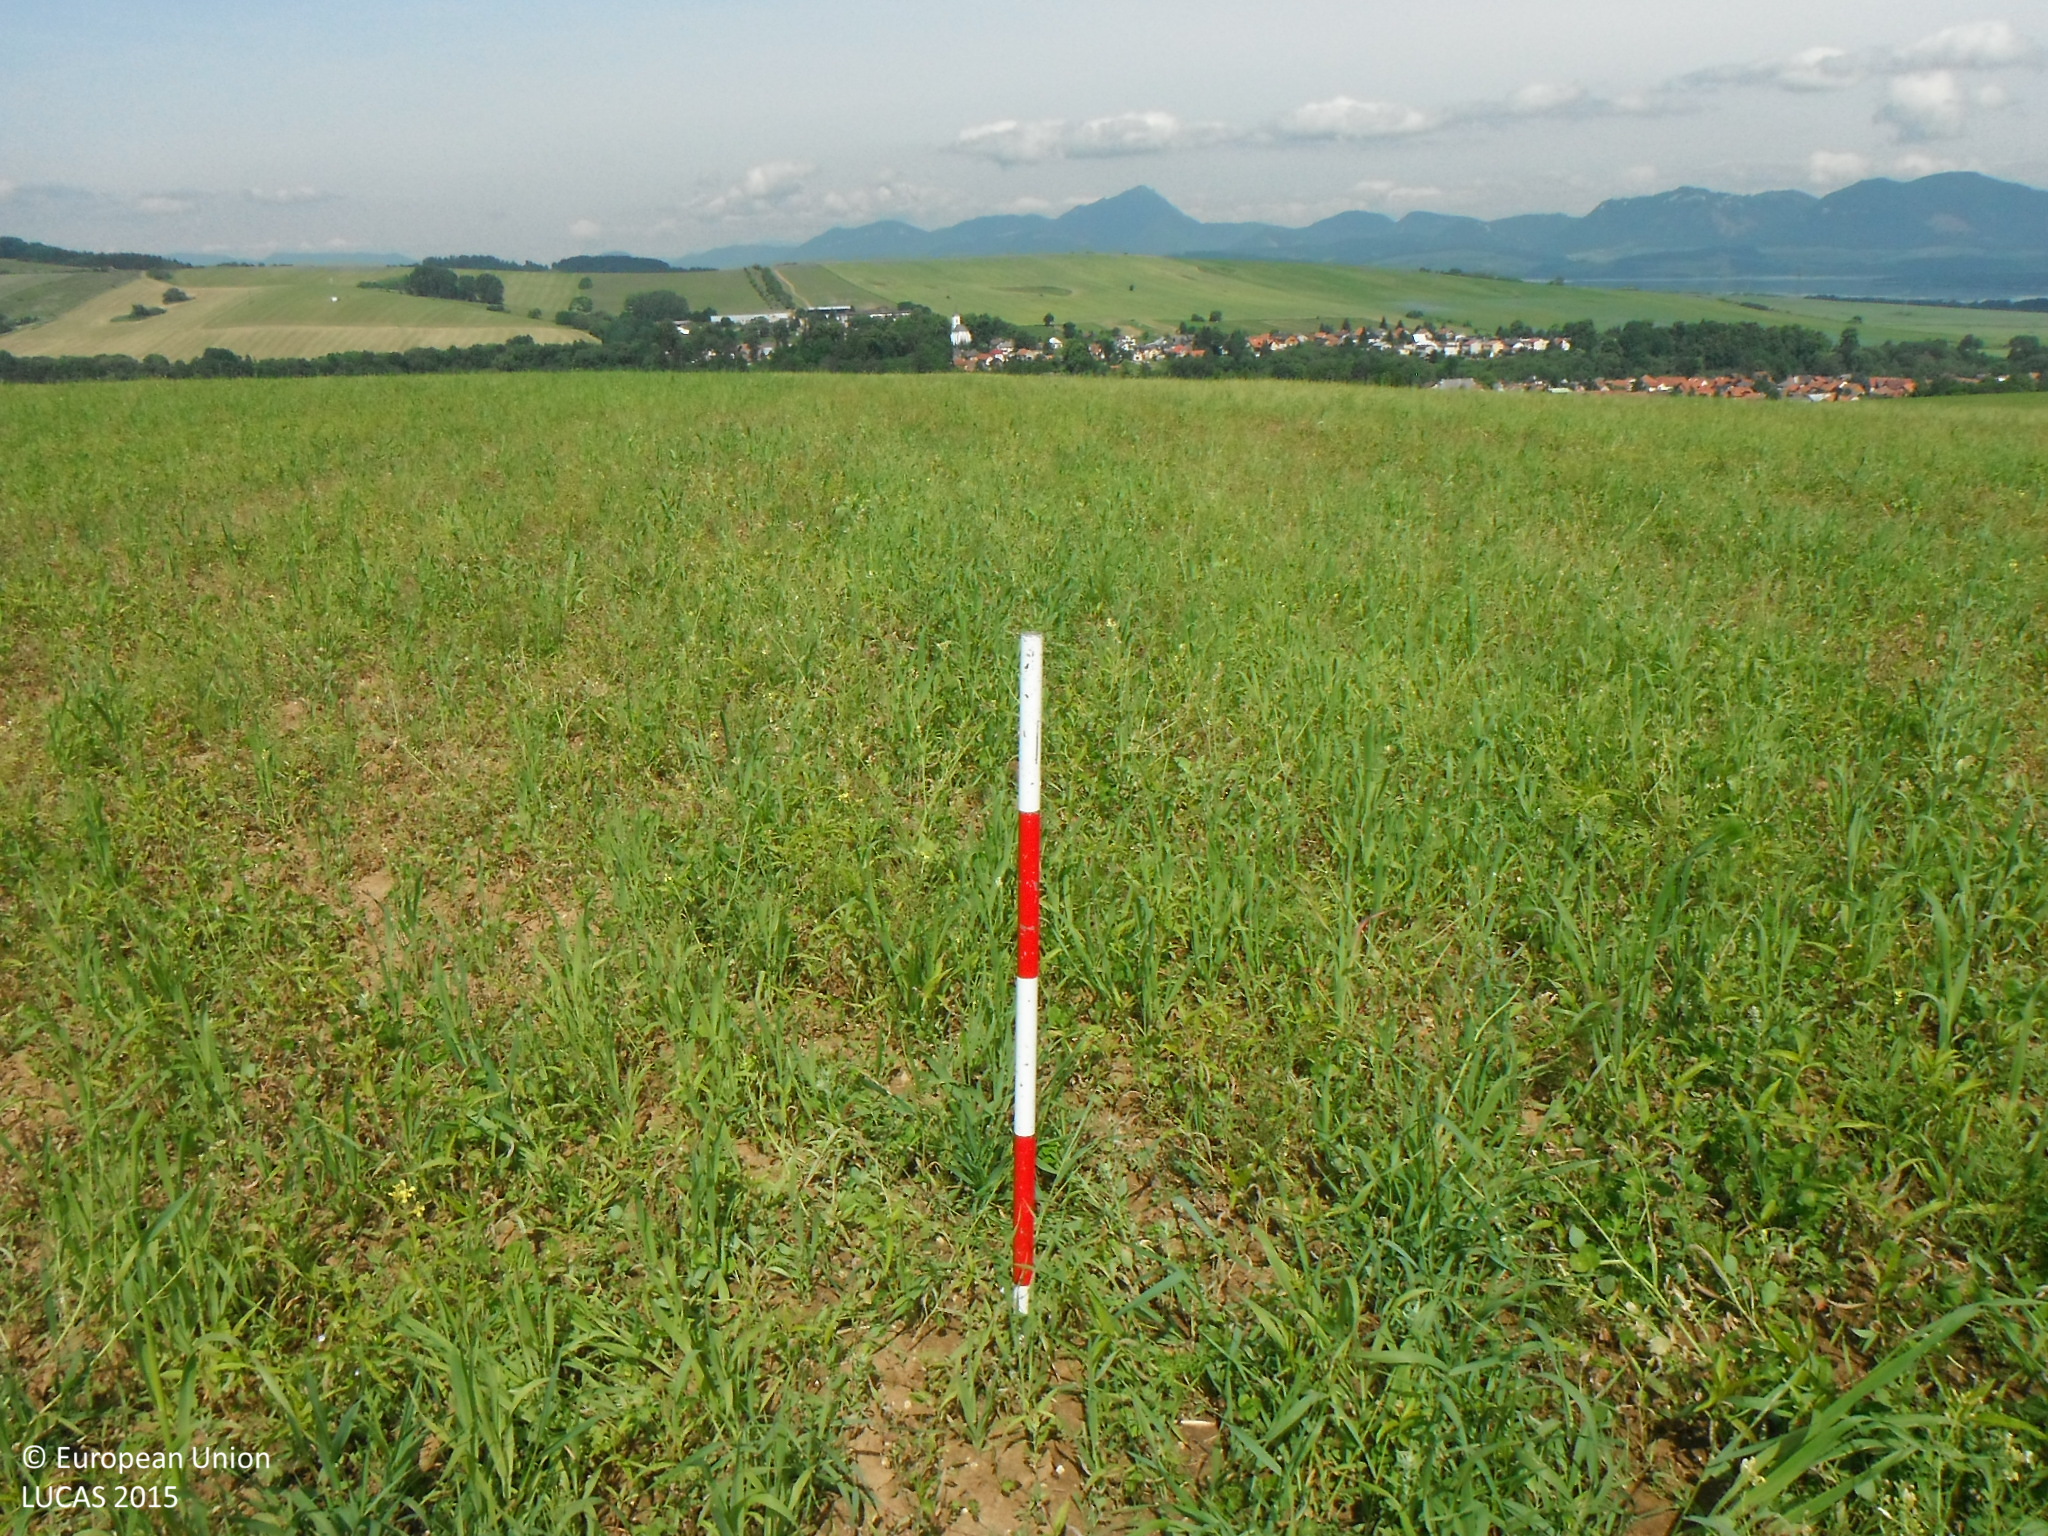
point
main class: Cropland
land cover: Other leguminous and mixtures for fodder
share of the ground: 50 - 75 %
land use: Agriculture (excluding fallow land and kitchen gardens)
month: June
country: SK
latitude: 49.0545
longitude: 19.5918
